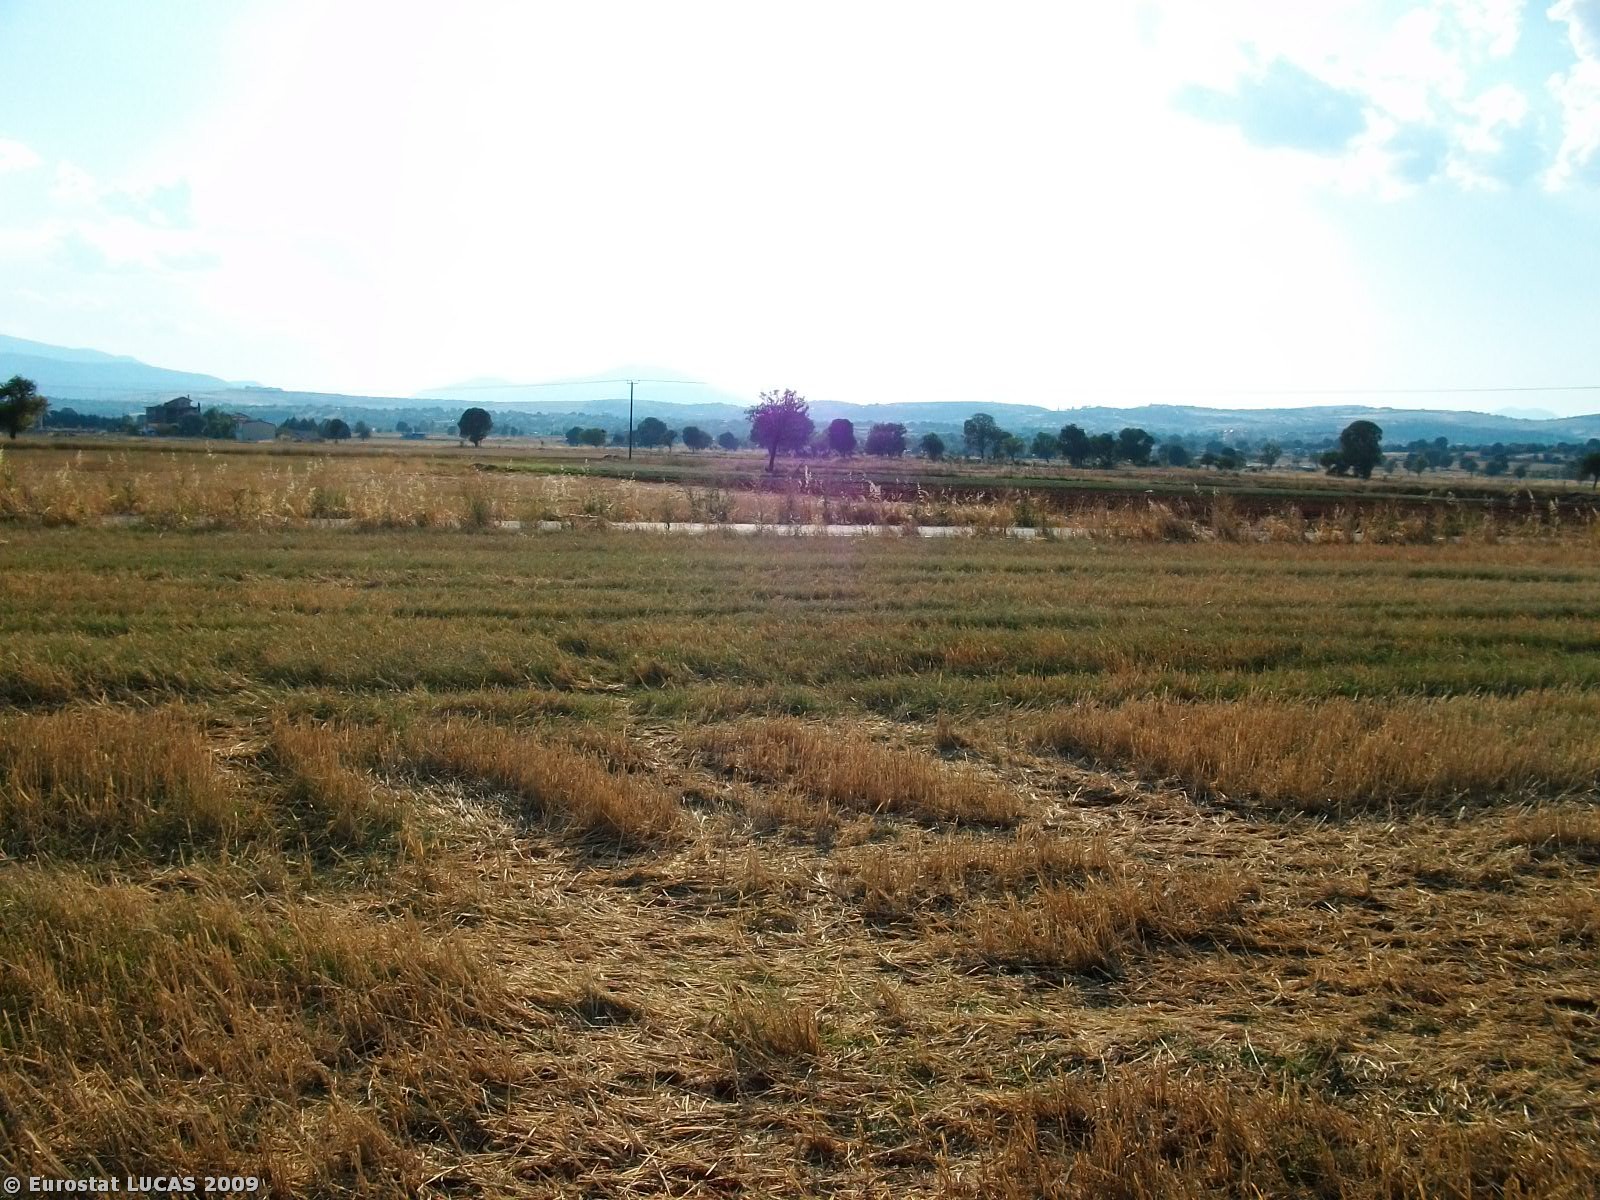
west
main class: Cropland
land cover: Durum wheat
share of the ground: < 10 %
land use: Agriculture (excluding fallow land and kitchen gardens)
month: July
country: GR
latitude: 40.2816
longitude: 21.8124
